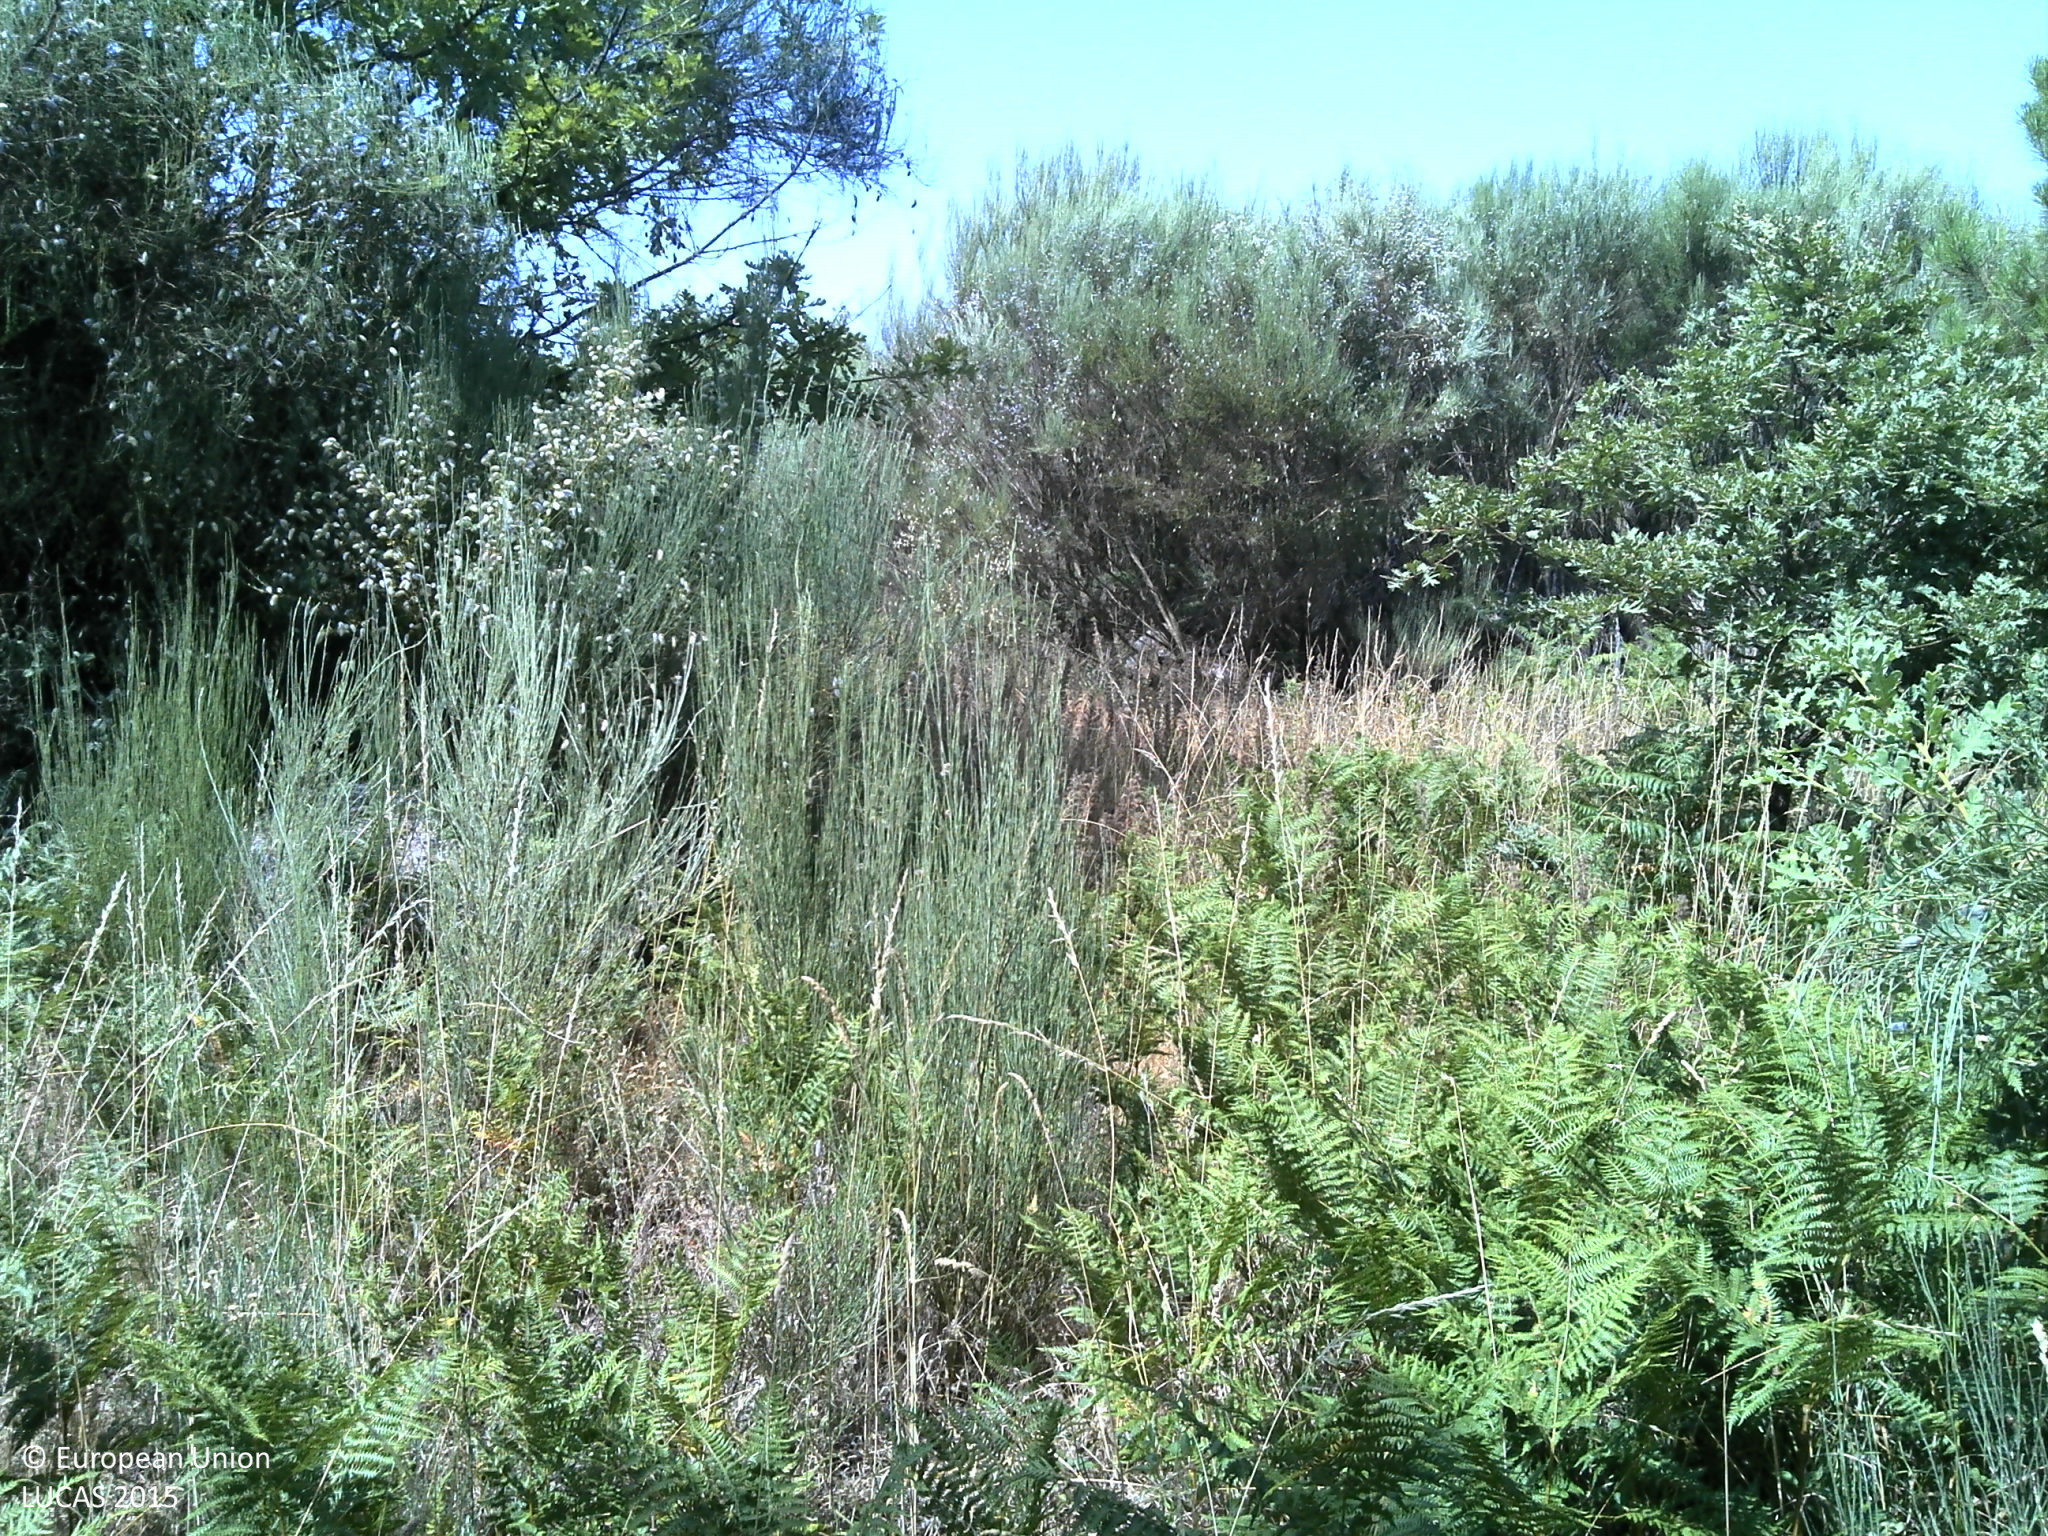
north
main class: Shrubland
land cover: Shrubland with sparse tree cover
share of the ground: 50 - 75 %
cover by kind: shrubs 55 %, unconsolidated bare surface 30 %, herbaceous plants 10 %, broadleaved forest trees 5 %
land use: Forestry
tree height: > 5 m
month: July
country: PT
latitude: 40.8948
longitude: -7.6042
